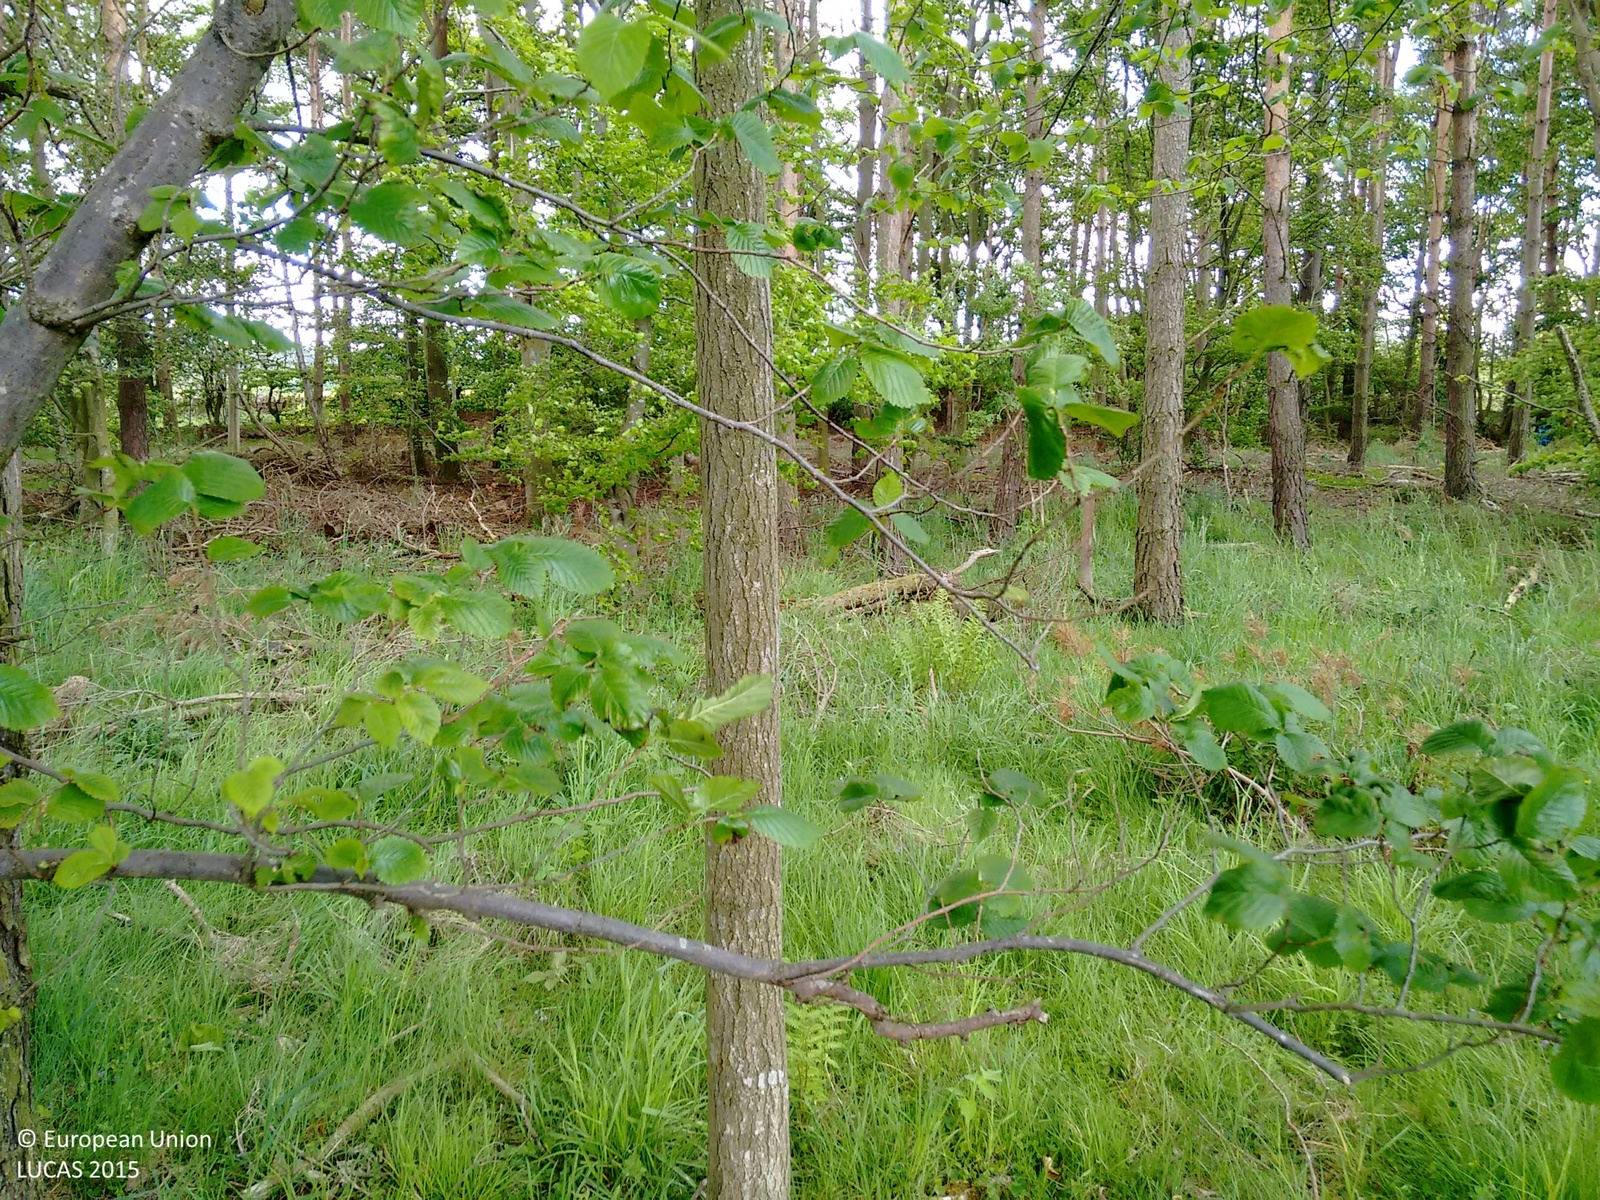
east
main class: Woodland
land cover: Pine dominated mixed woodland
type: exotic forest
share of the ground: > 75 %
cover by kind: coniferous forest trees 65 %, broadleaved forest trees 25 %, herbaceous plants 10 %
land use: Semi-natural and natural areas not in use
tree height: > 5 m
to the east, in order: Pine dominated mixed woodland; Ditches and canals; Pine dominated mixed woodland; Grass margins; Paved roads, cycling and walking lanes; Grass margins; Dry stone walls; Grassland without tree/shrub cover; Common wheat; Grassland without tree/shrub cover; Electric lines; Paved roads, cycling and walking lanes; Grass margins; Lines of trees; Fences; Grassland without tree/shrub cover; Barley
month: May
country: GB
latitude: 55.9097
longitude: -2.7823
